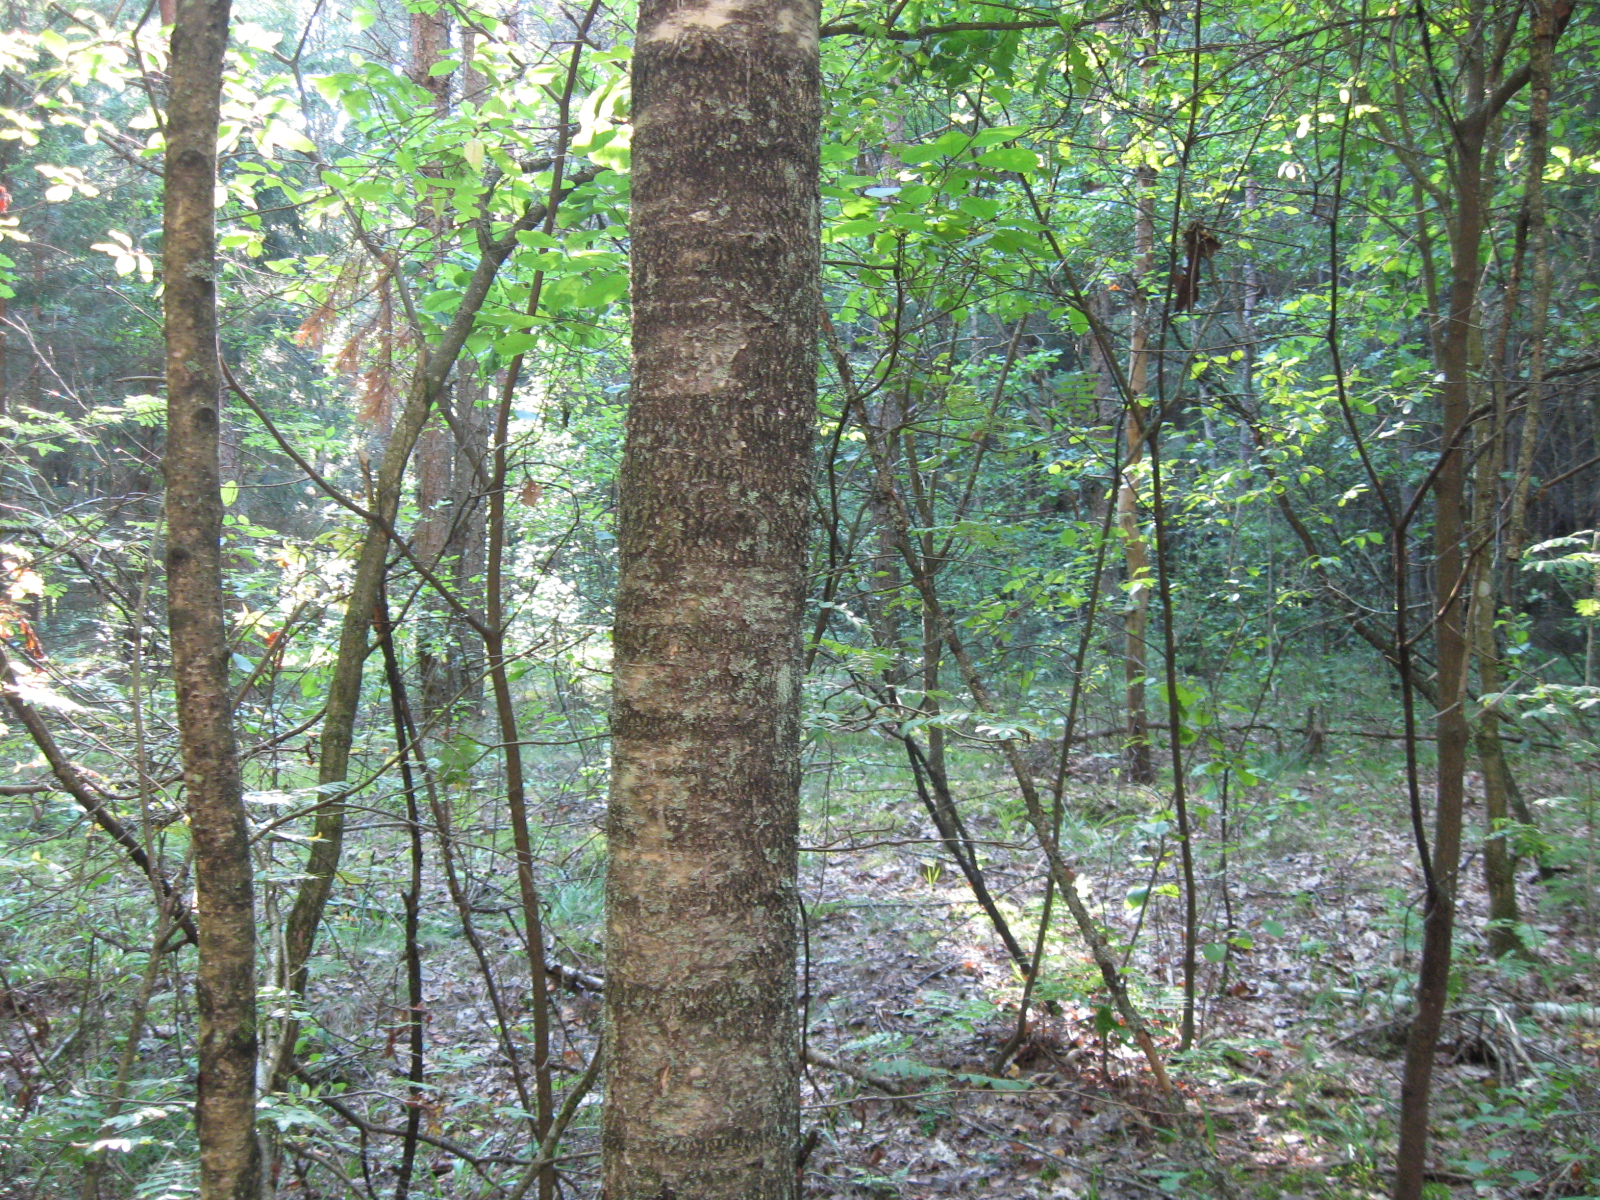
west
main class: Woodland
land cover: Spruce dominated mixed woodland
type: hemiboreal forest and nemoral coniferous forest and mixed broadleaved-coniferous forest
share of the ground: > 75 %
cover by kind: coniferous forest trees 55 %, broadleaved forest trees 30 %, herbaceous plants 10 %, unconsolidated bare surface 5 %
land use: Forestry
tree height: > 5 m
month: August
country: LT
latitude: 54.8712
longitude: 23.4662
